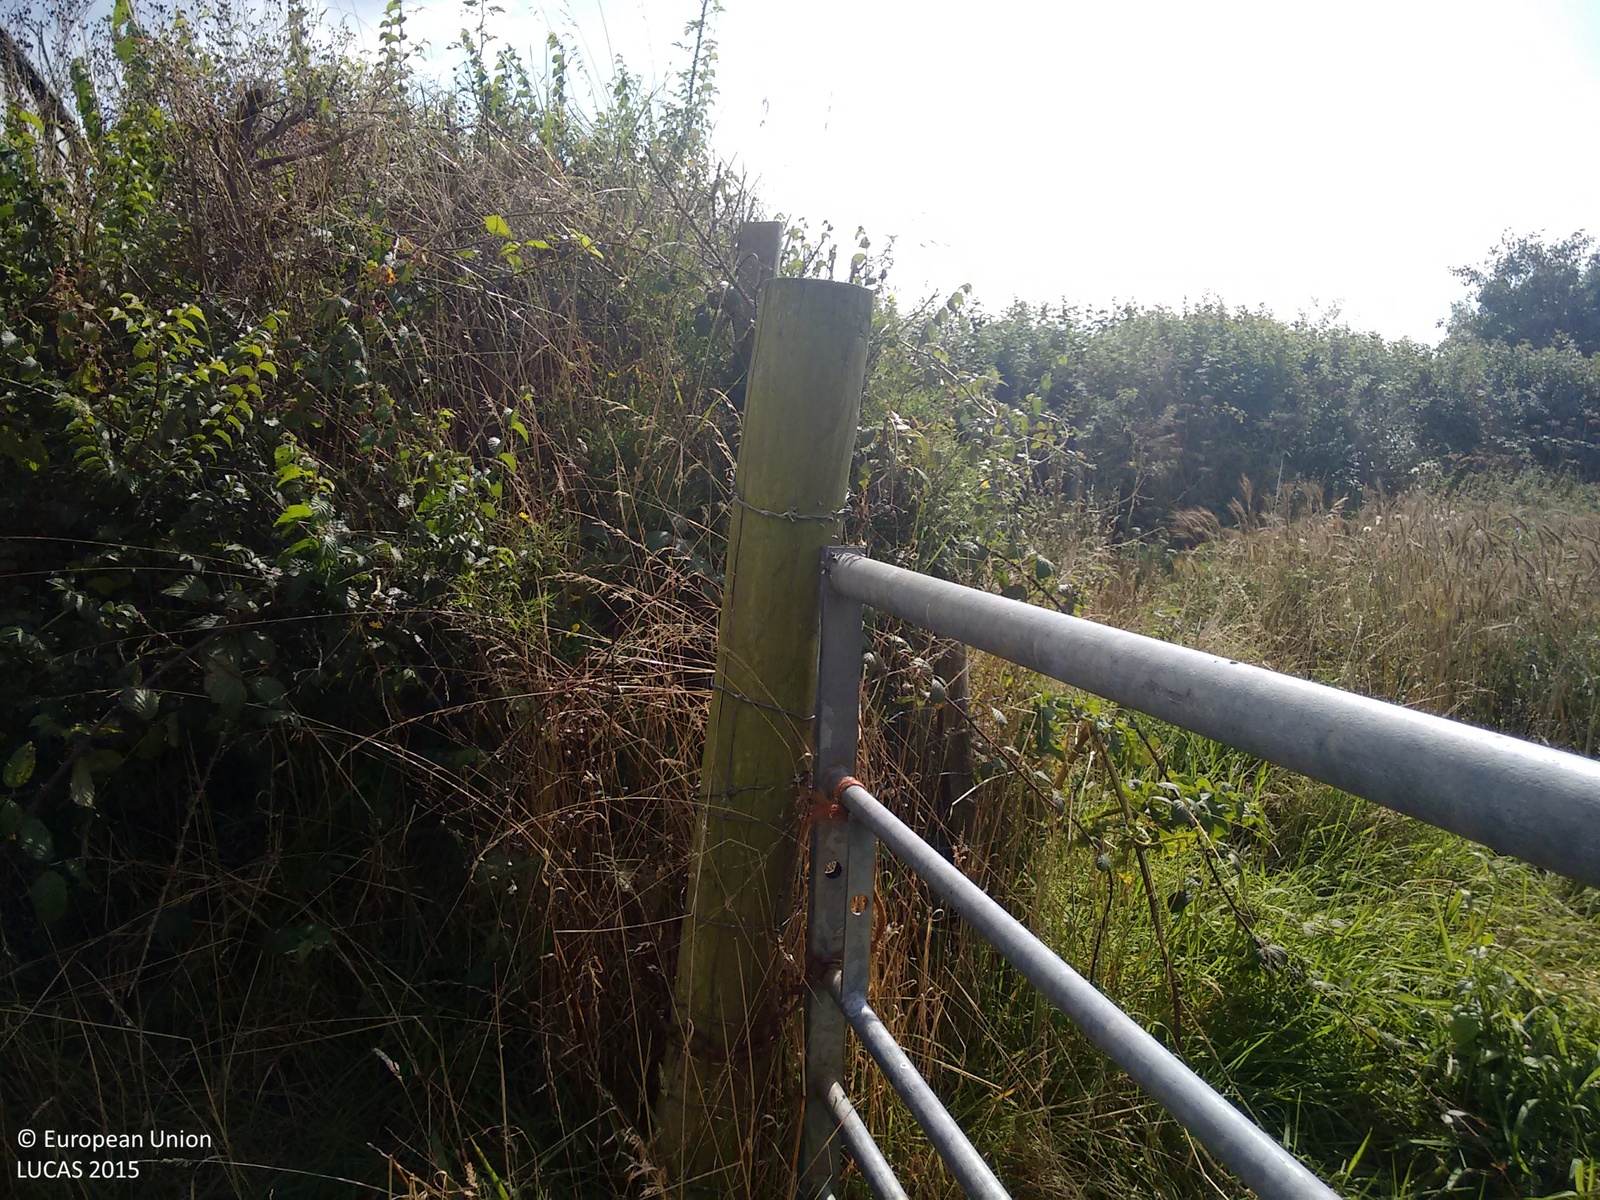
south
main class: Cropland
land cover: Barley
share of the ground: > 75 %
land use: Agriculture (excluding fallow land and kitchen gardens)
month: September
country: GB
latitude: 50.9193
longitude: -4.1662
